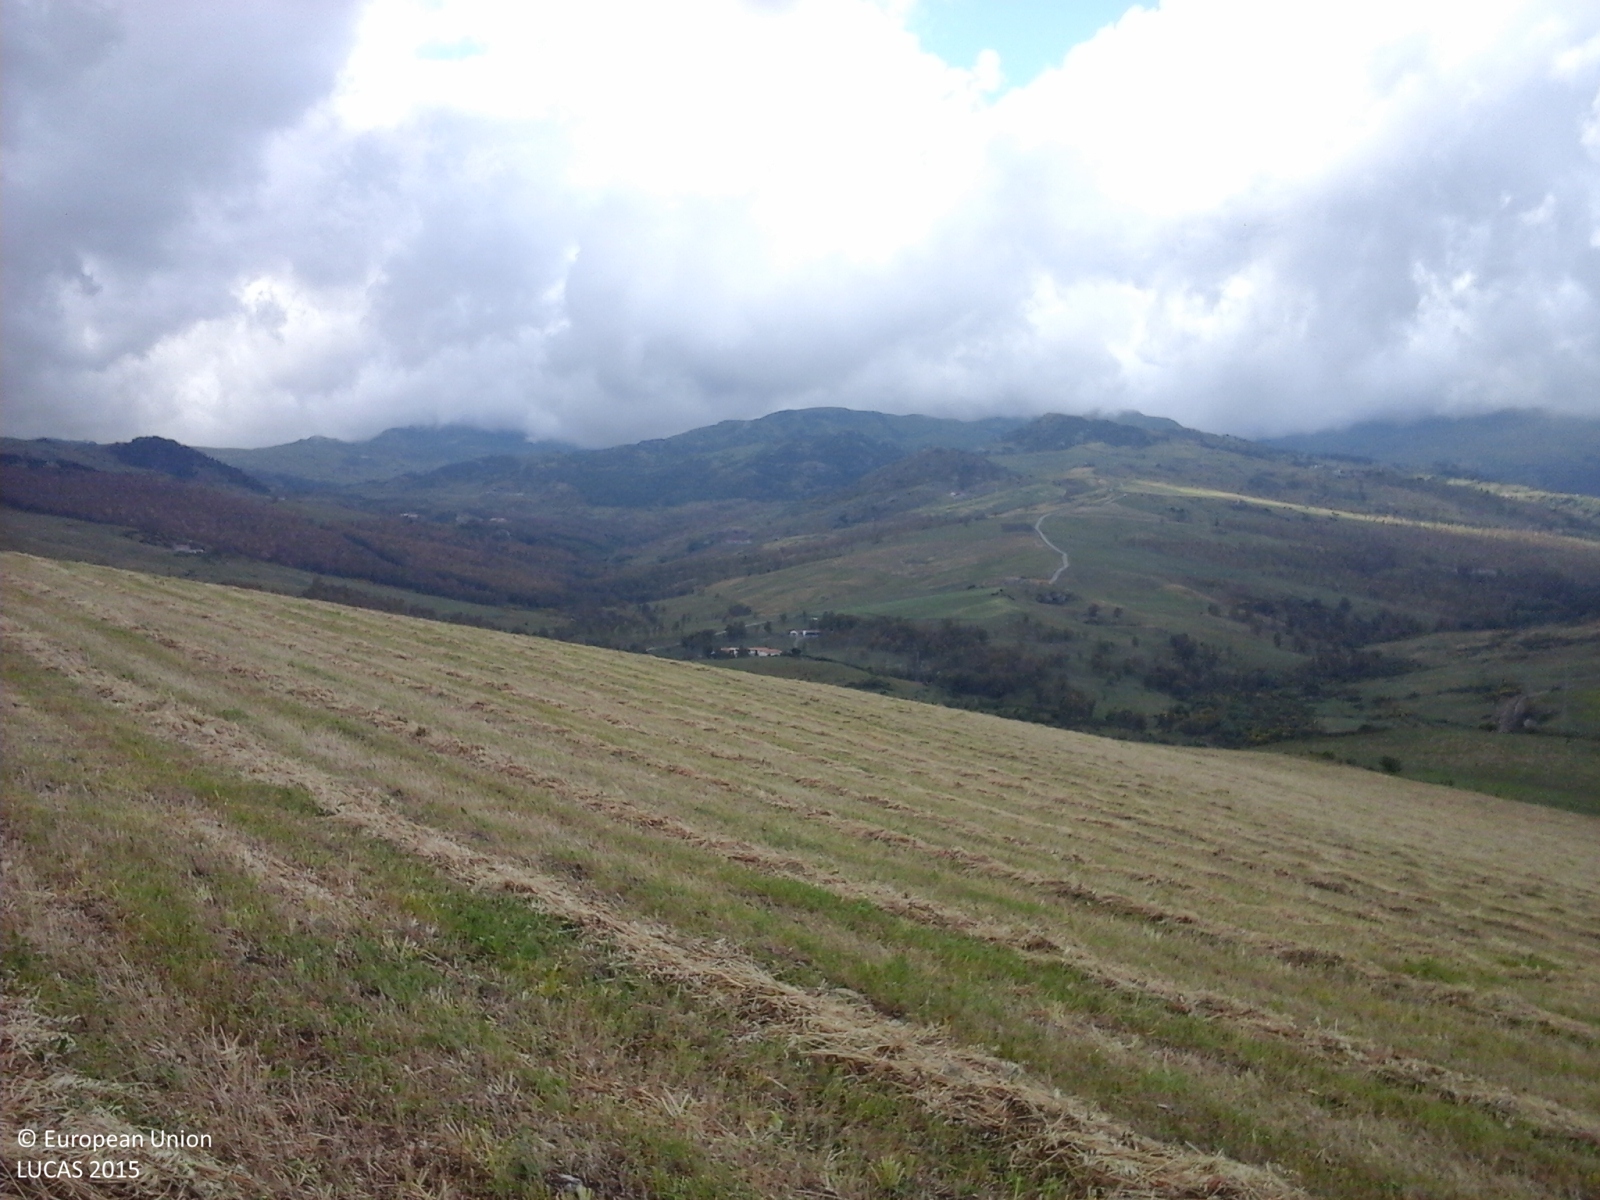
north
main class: Cropland
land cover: Temporary grasslands
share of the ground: > 75 %
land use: Agriculture (excluding fallow land and kitchen gardens)
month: May
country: IT
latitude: 37.8067
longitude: 14.4551
